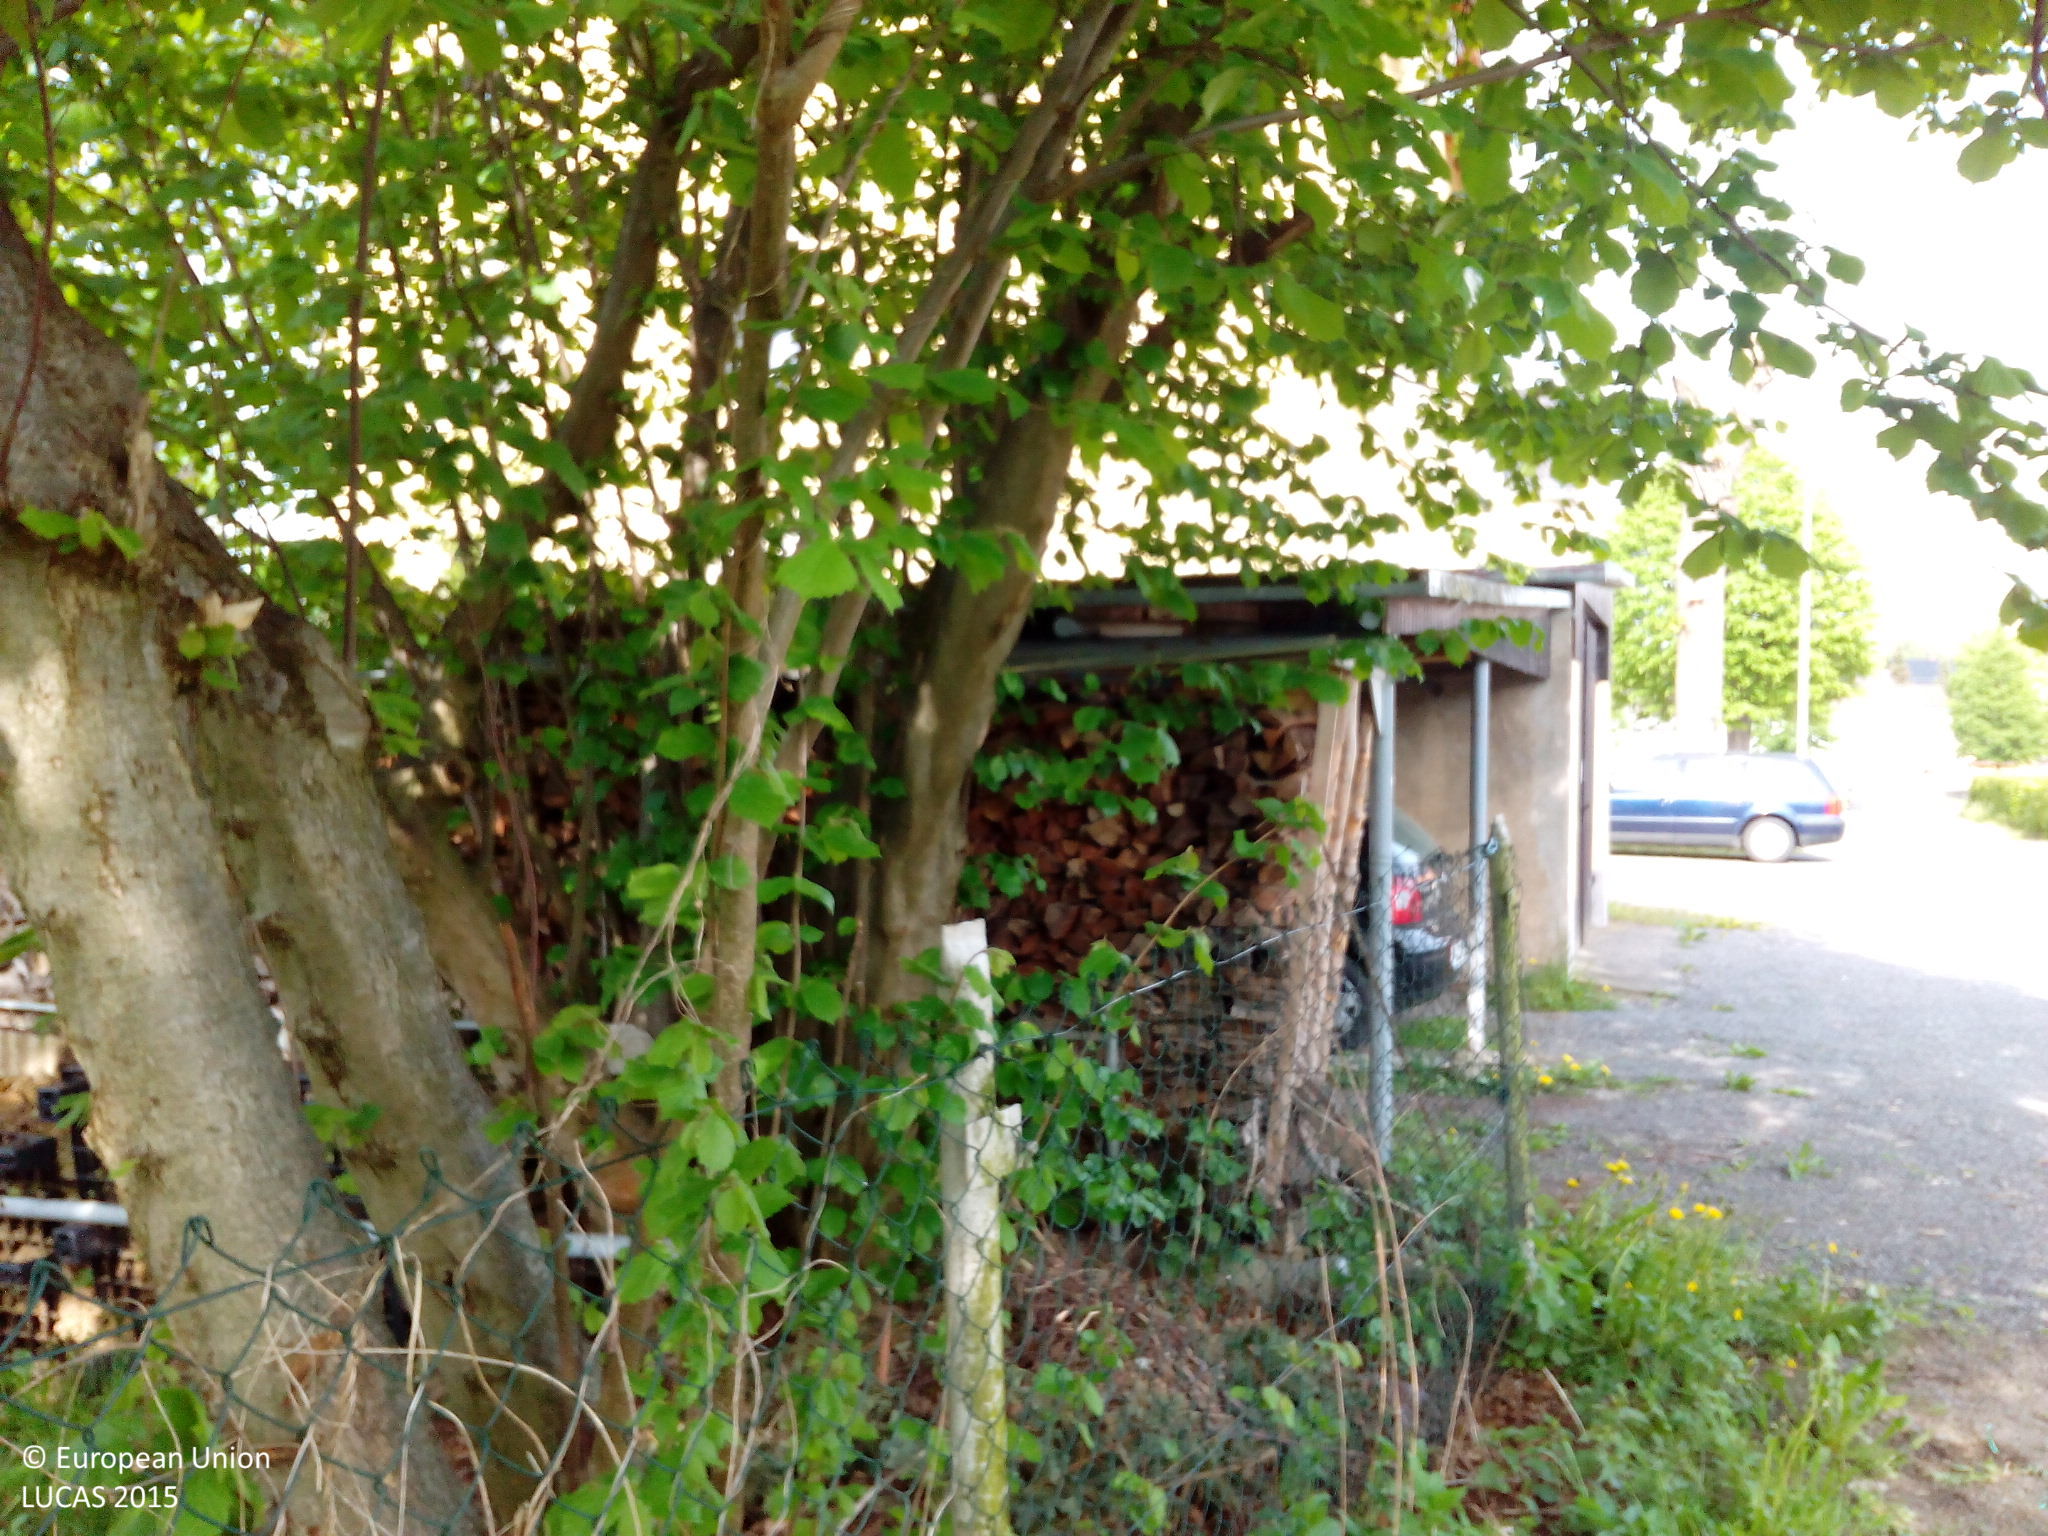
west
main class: Woodland
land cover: Broadleaved woodland
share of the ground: 10 - 25 %
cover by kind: consolidated bare surface 55 %, herbaceous plants 25 %, broadleaved forest trees 20 %
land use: Residential
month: May
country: DE
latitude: 50.8444
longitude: 13.0819
